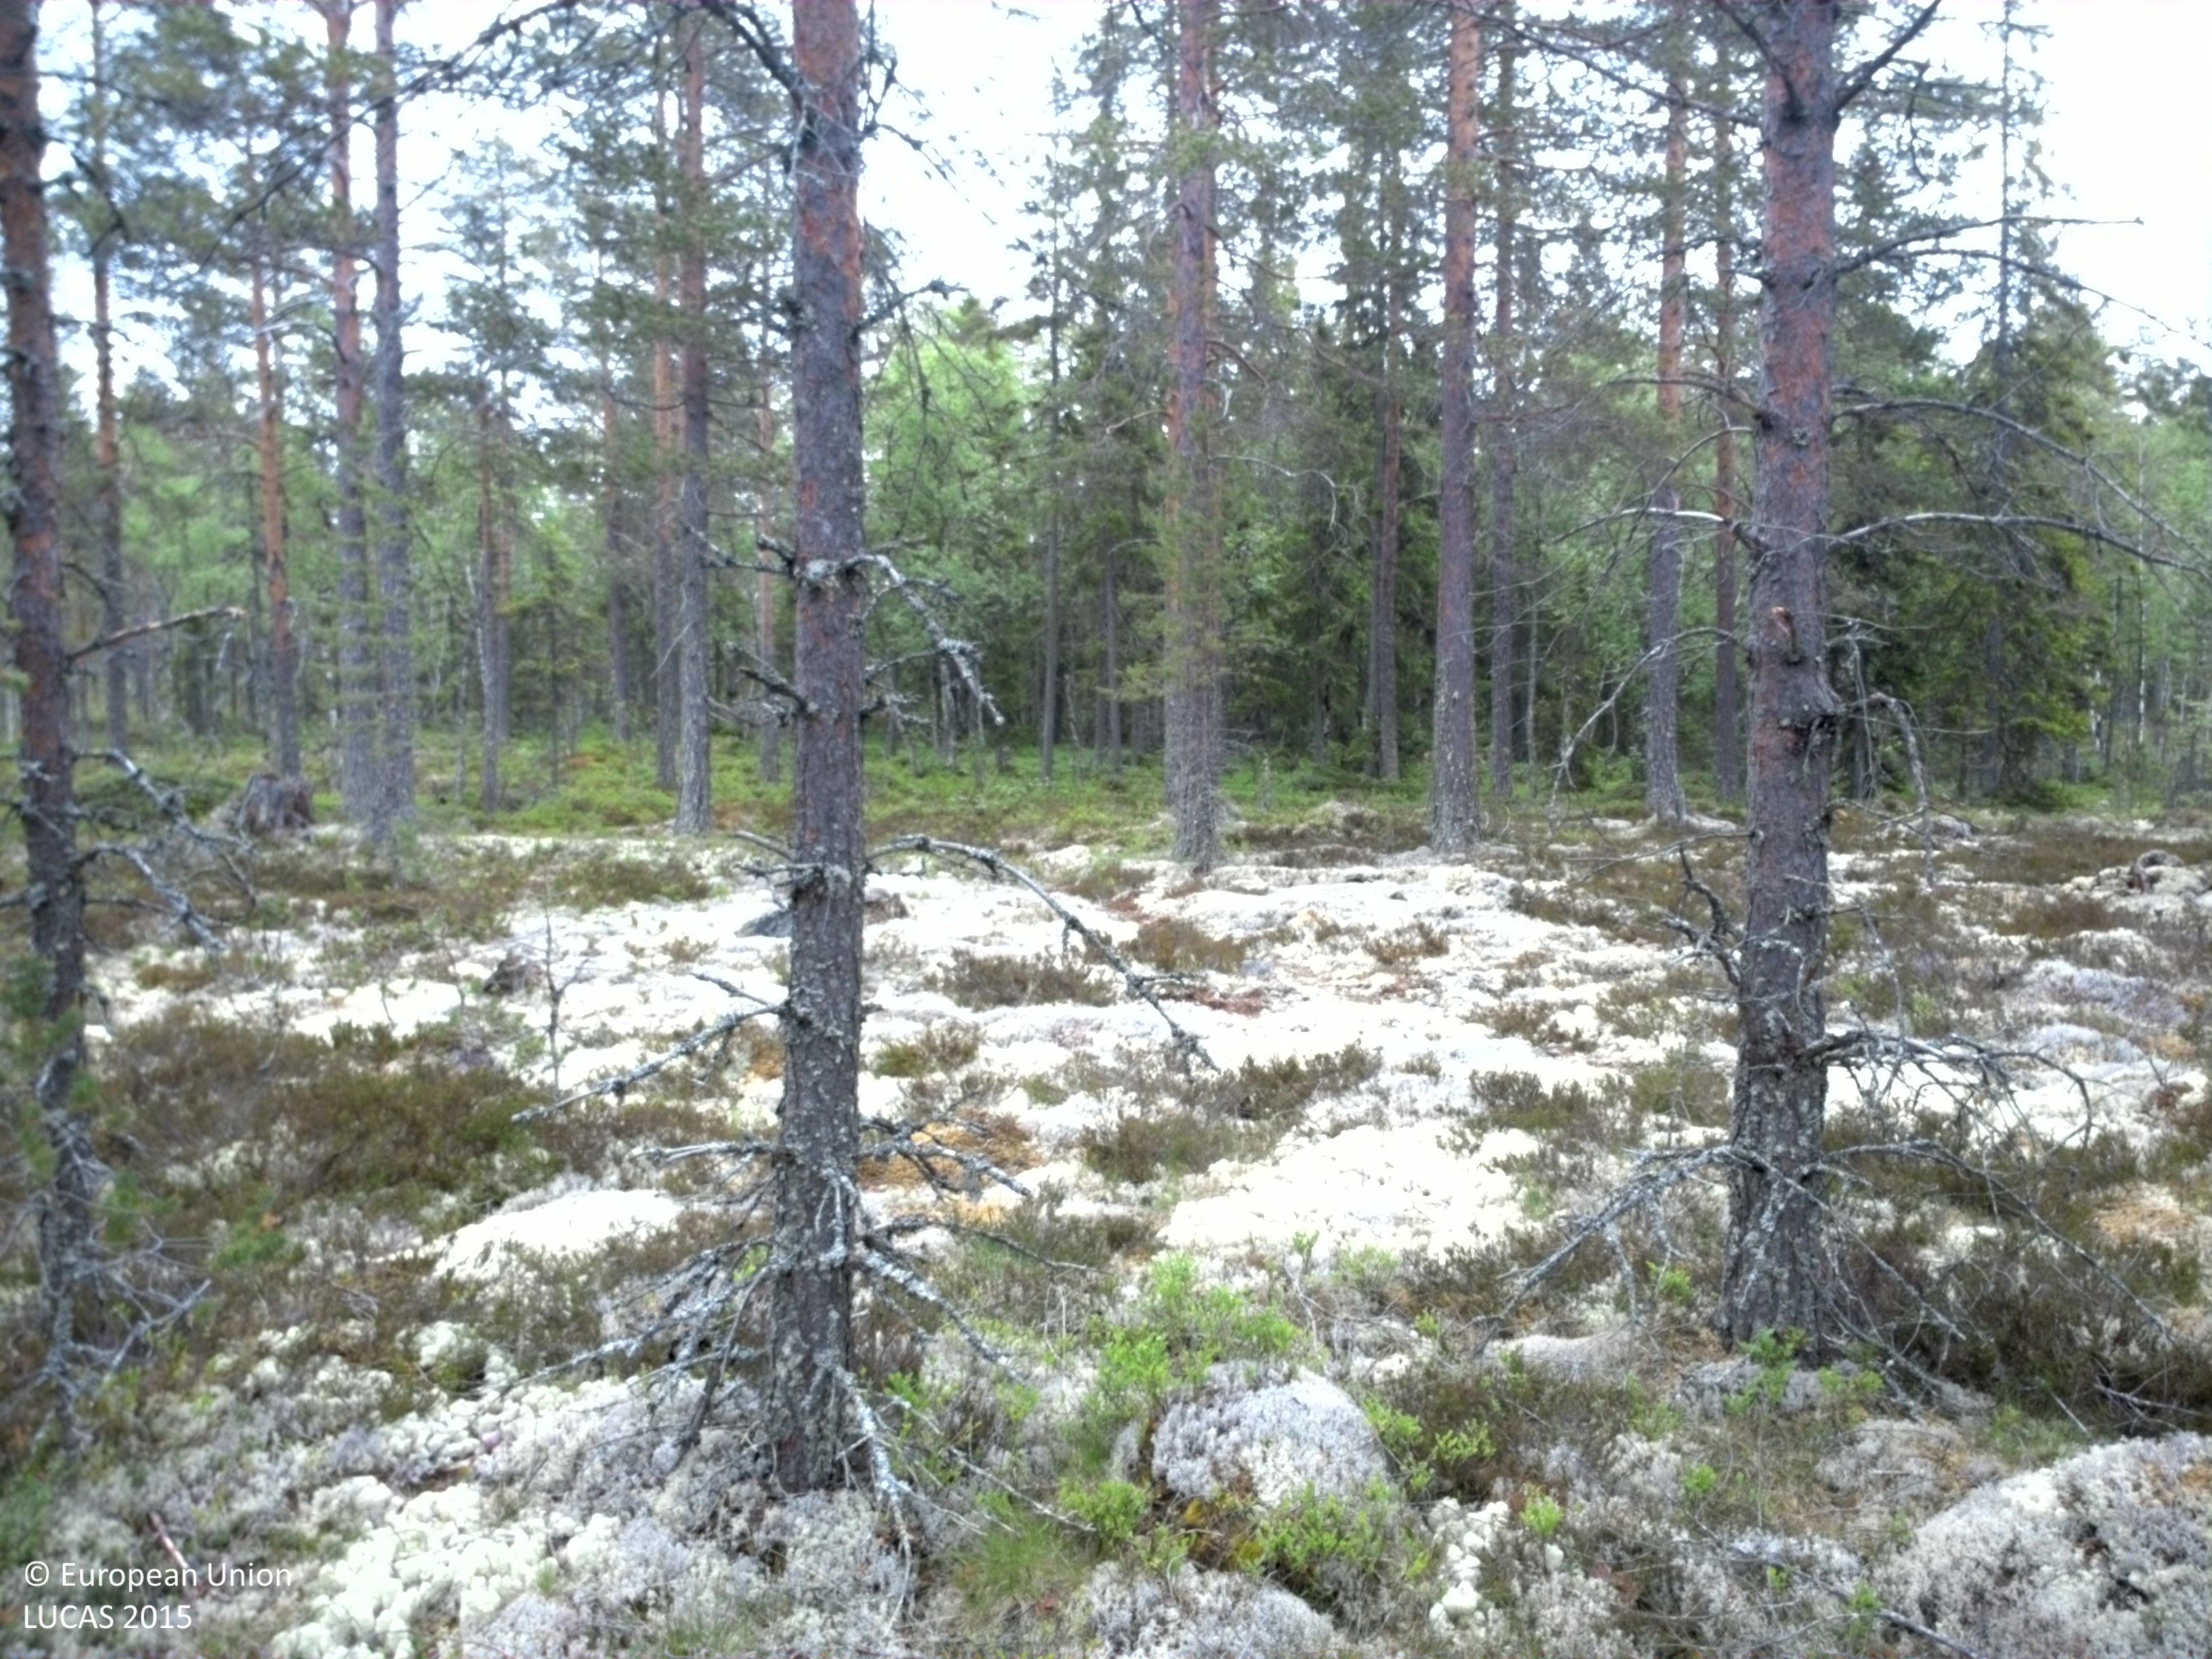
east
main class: Woodland
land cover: Pine dominated coniferous woodland
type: boreal forest
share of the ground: 50 - 75 %
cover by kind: coniferous forest trees 60 %, herbaceous plants 15 %, lichens and mosses 15 %, broadleaved forest trees 10 %
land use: Forestry
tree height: > 5 m
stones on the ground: < 10 %
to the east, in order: Pine dominated coniferous woodland; Pine dominated mixed woodland; Rivers and streams; Pine dominated mixed woodland; Pine dominated coniferous woodland; Peatbogs; Pine dominated coniferous woodland
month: June
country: SE
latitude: 61.1979
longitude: 13.6161
